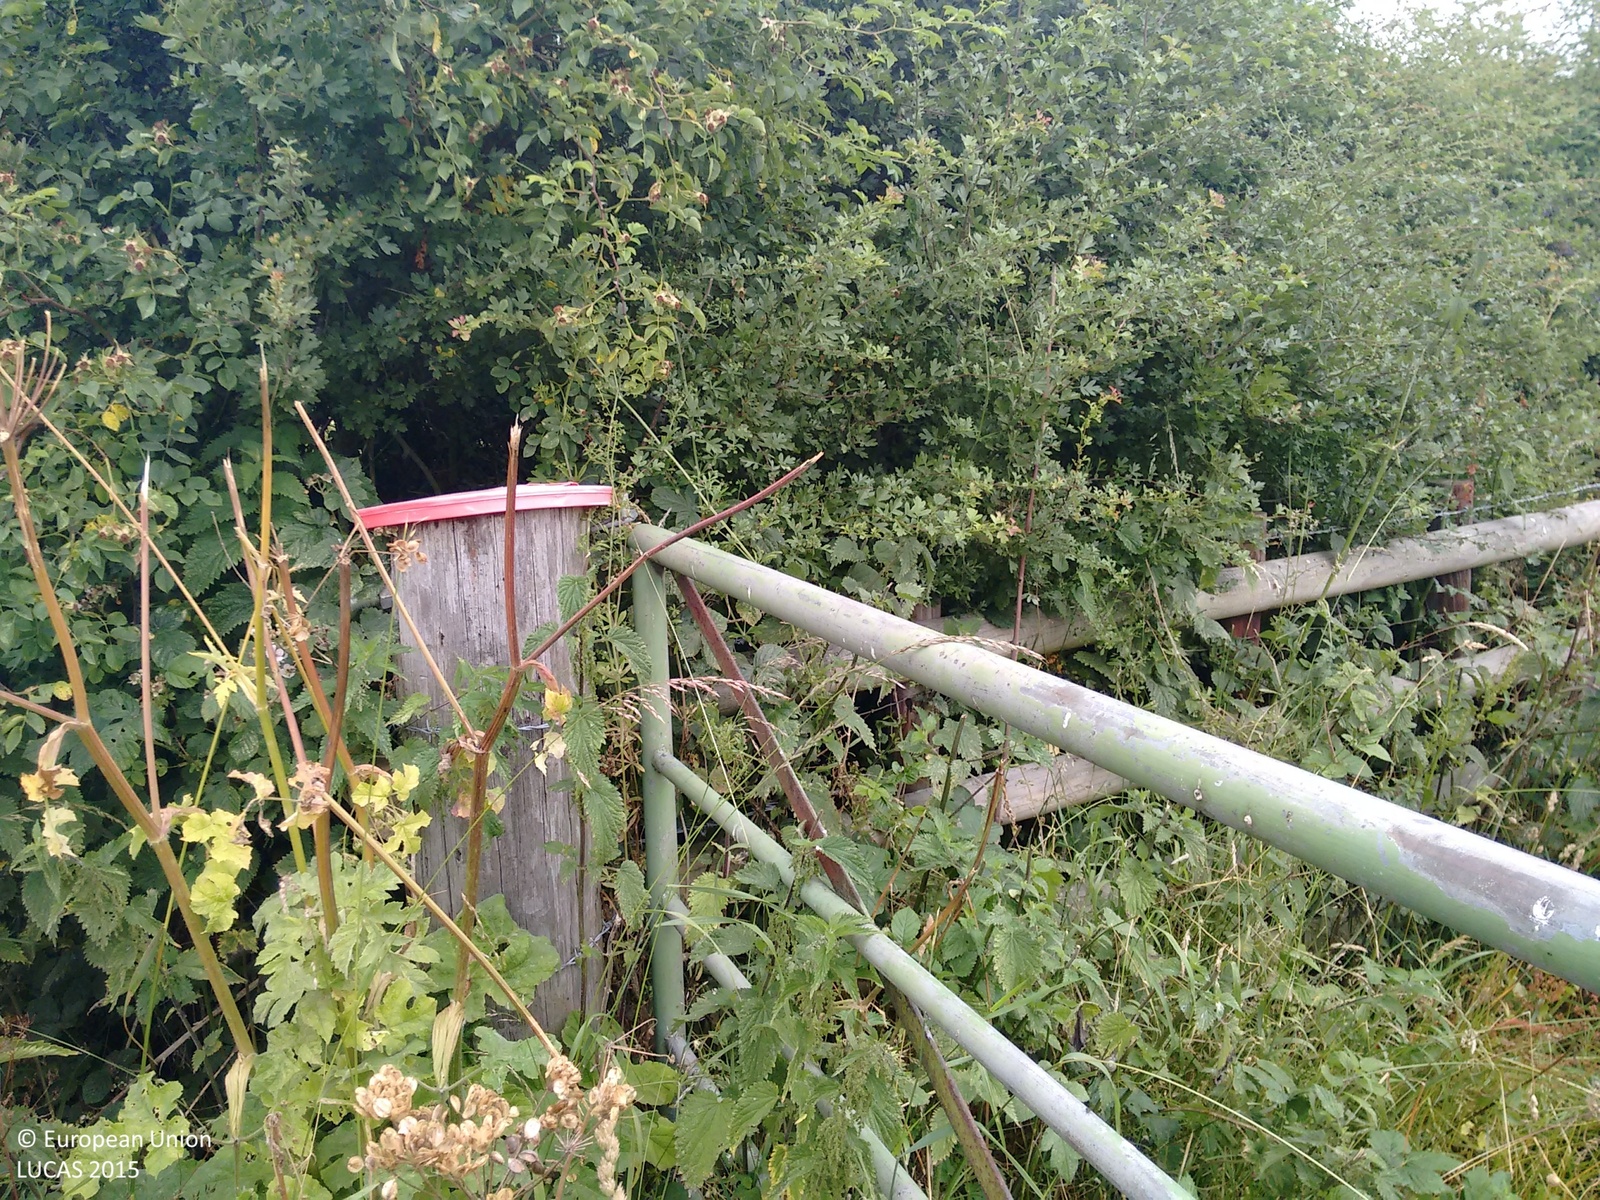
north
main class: Grassland
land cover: Grassland without tree/shrub cover
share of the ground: > 75 %
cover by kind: herbaceous plants 100 %
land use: Agriculture (excluding fallow land and kitchen gardens)
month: July
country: GB
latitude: 52.8817
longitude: -1.5681
